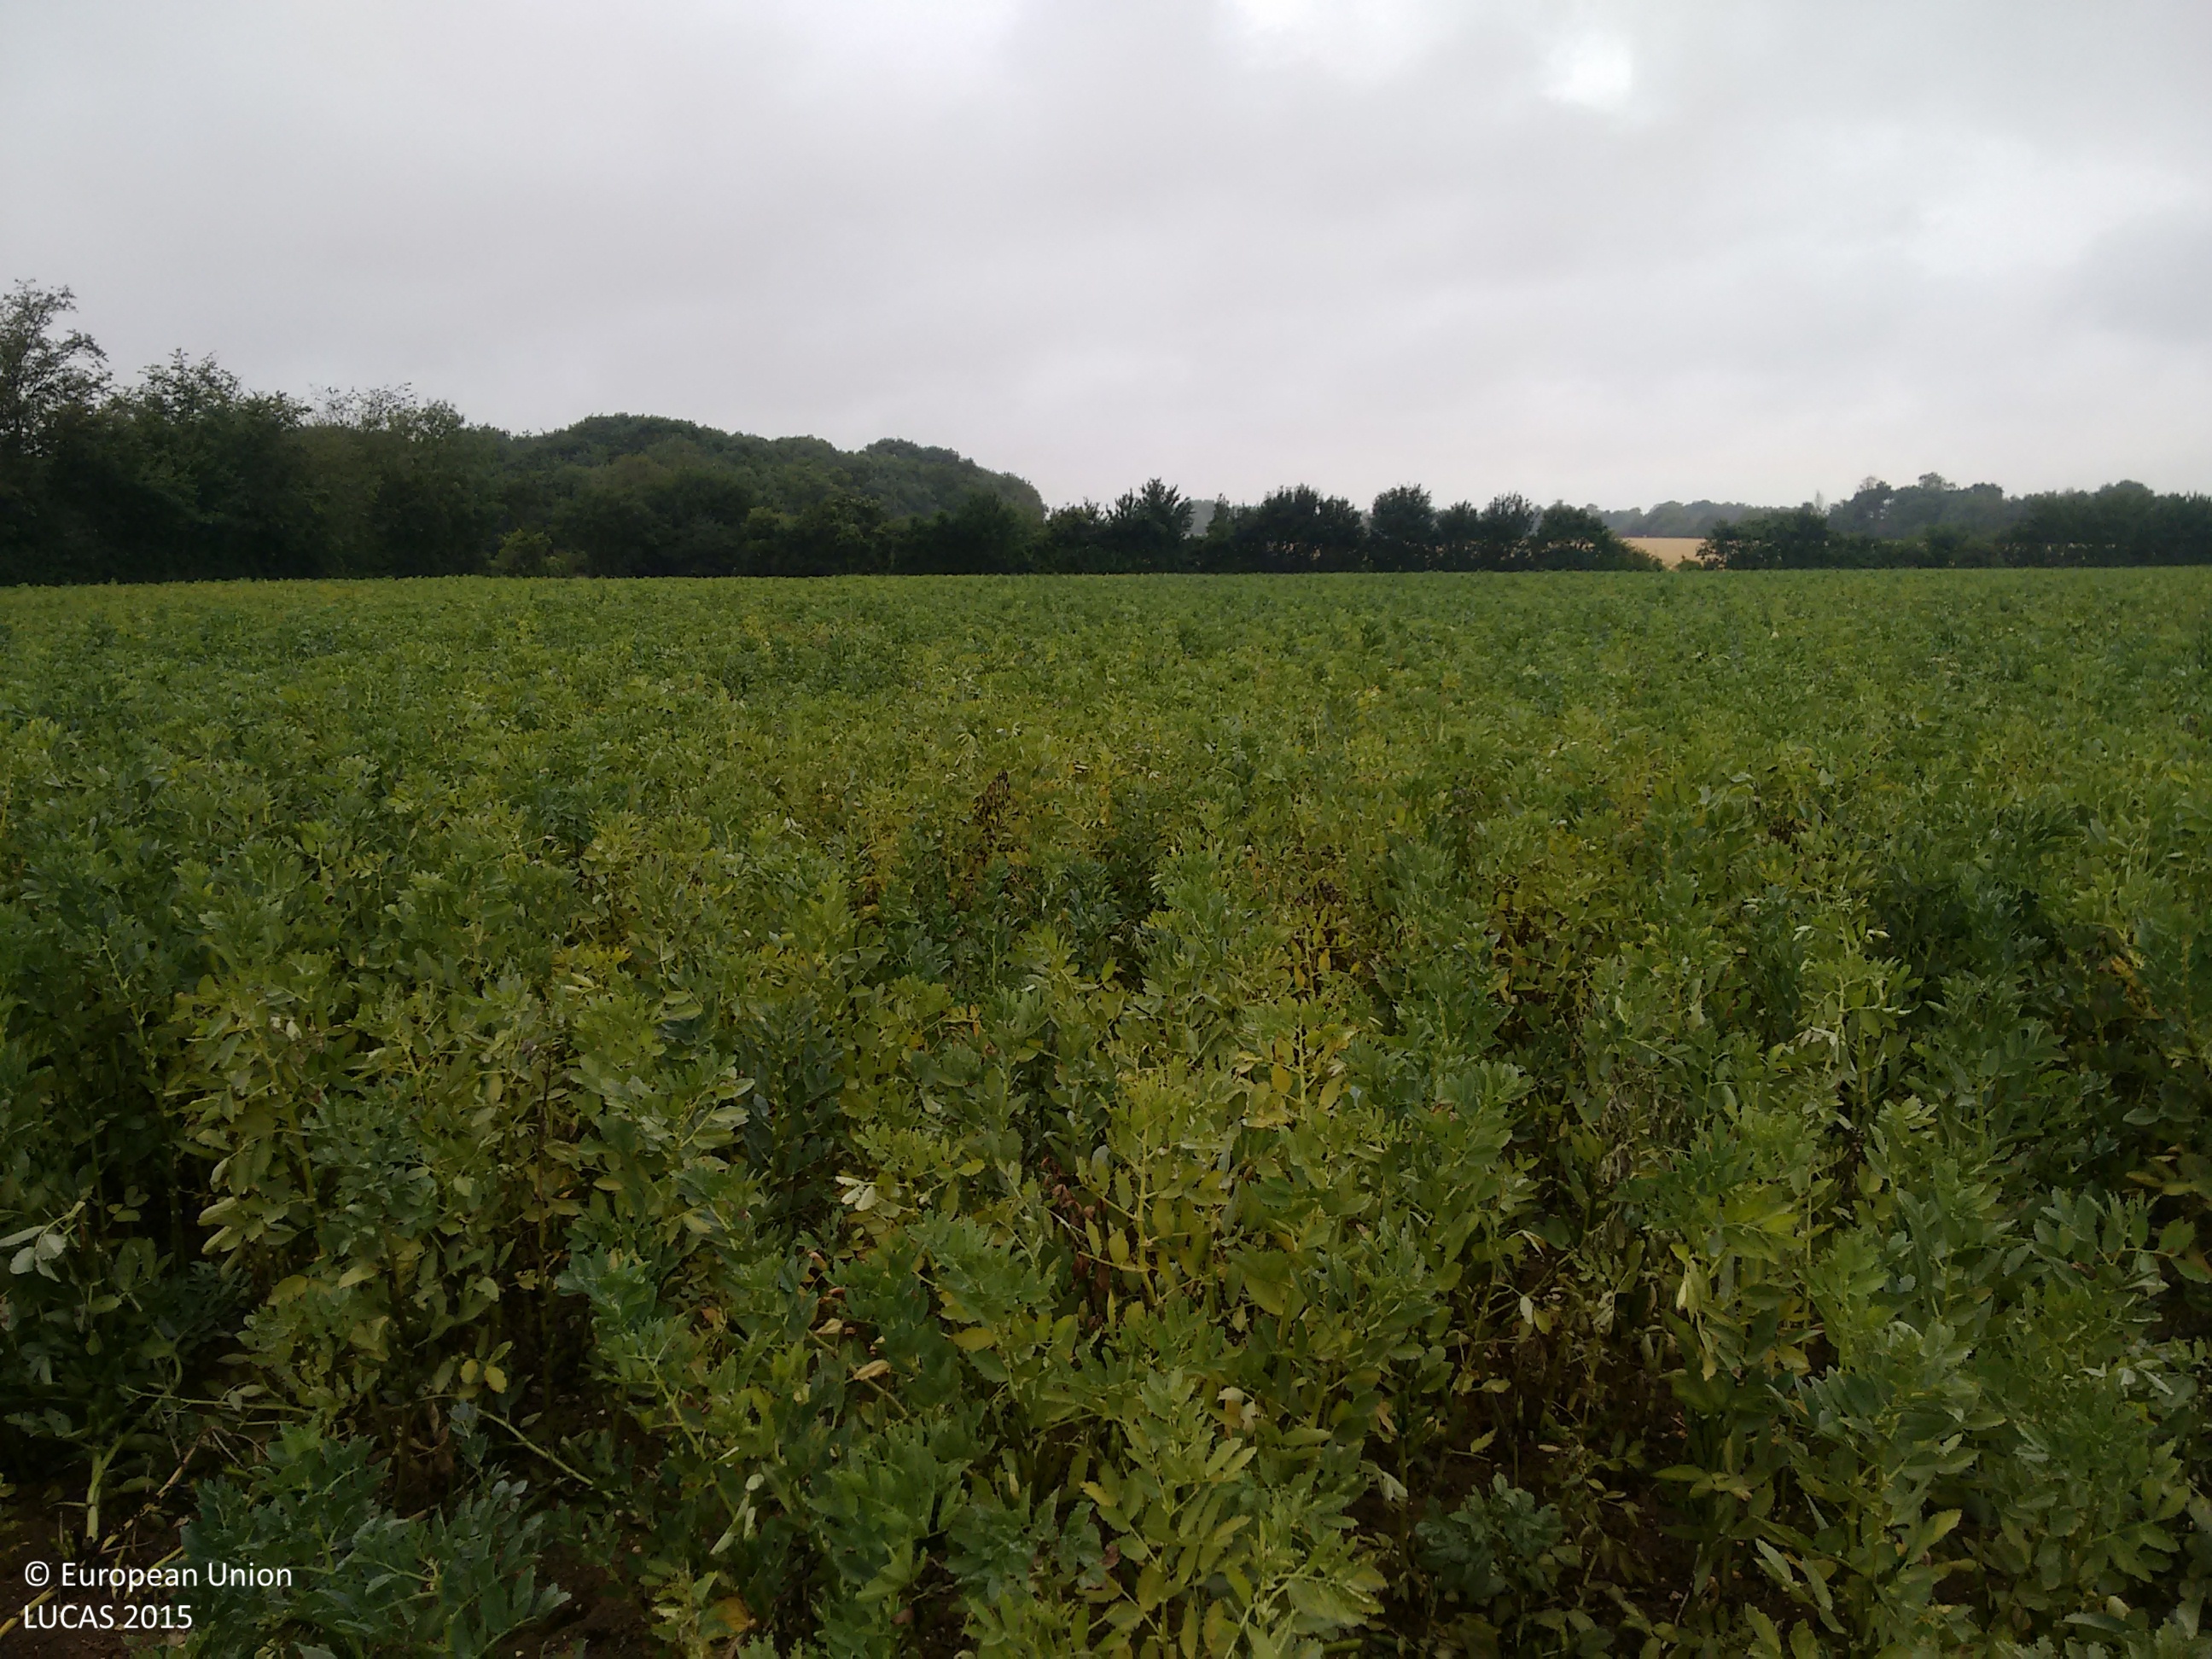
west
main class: Cropland
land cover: Dry pulses
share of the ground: > 75 %
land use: Agriculture (excluding fallow land and kitchen gardens)
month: July
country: GB
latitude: 51.7827
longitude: 0.3310
